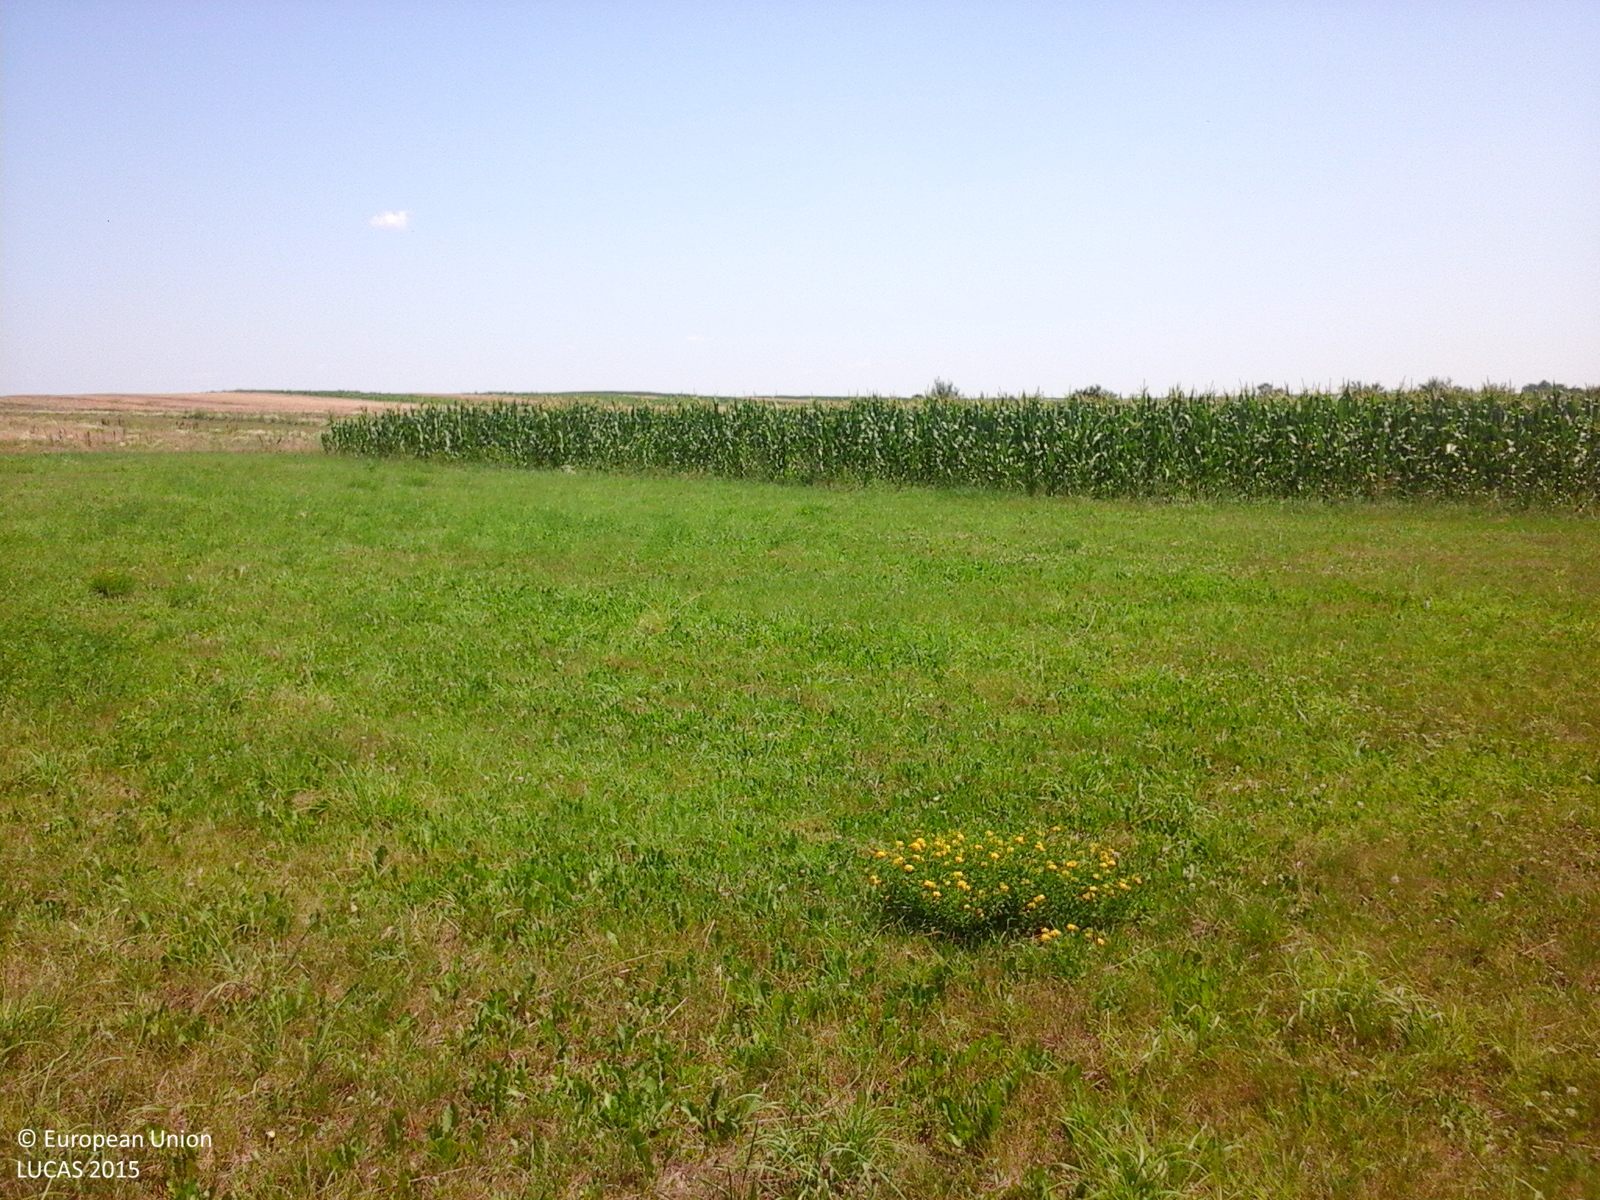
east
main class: Cropland
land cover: Common wheat
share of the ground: > 75 %
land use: Agriculture (excluding fallow land and kitchen gardens)
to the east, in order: Common wheat; Grassland without tree/shrub cover; Maize; Grassland without tree/shrub cover; Spontaneously vegetated surfaces; Tracks; Spontaneously vegetated surfaces; Shrubland with sparse tree cover; Spontaneously vegetated surfaces; Tracks; Grass margins; Common wheat; Maize
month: July
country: RO
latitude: 44.4765
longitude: 24.6445
